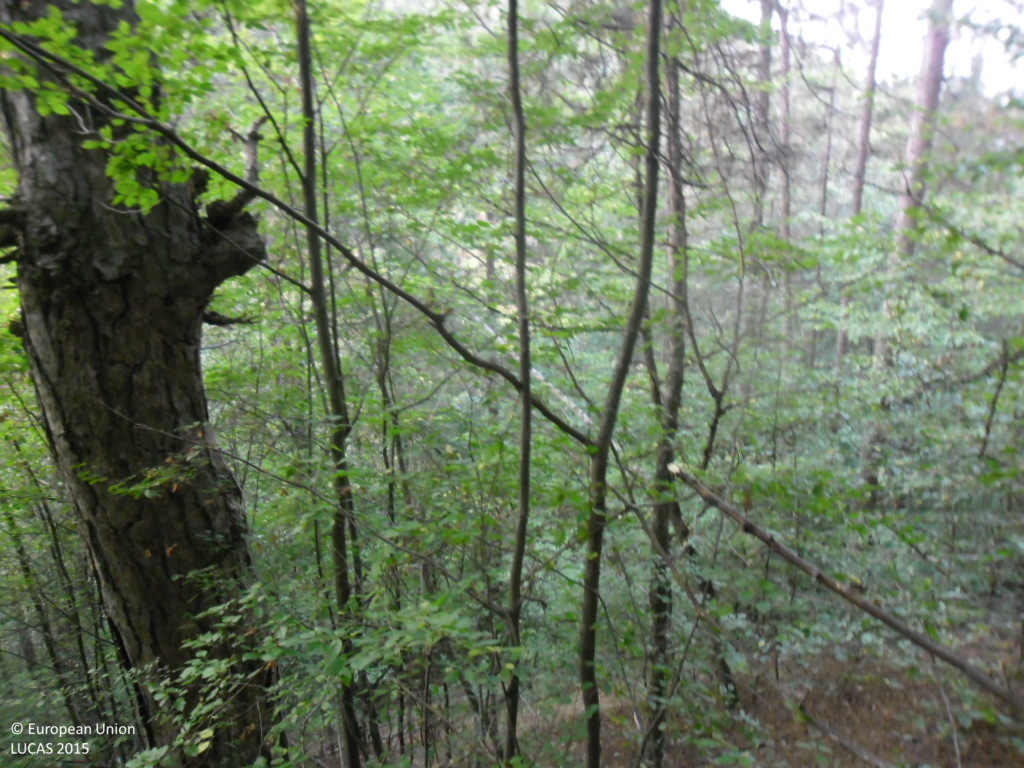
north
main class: Woodland
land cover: Pine dominated mixed woodland
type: hemiboreal forest and nemoral coniferous forest and mixed broadleaved-coniferous forest
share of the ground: > 75 %
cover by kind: coniferous forest trees 65 %, broadleaved forest trees 35 %
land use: Forestry
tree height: > 5 m
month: September
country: BG
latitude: 41.8946
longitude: 22.9295
